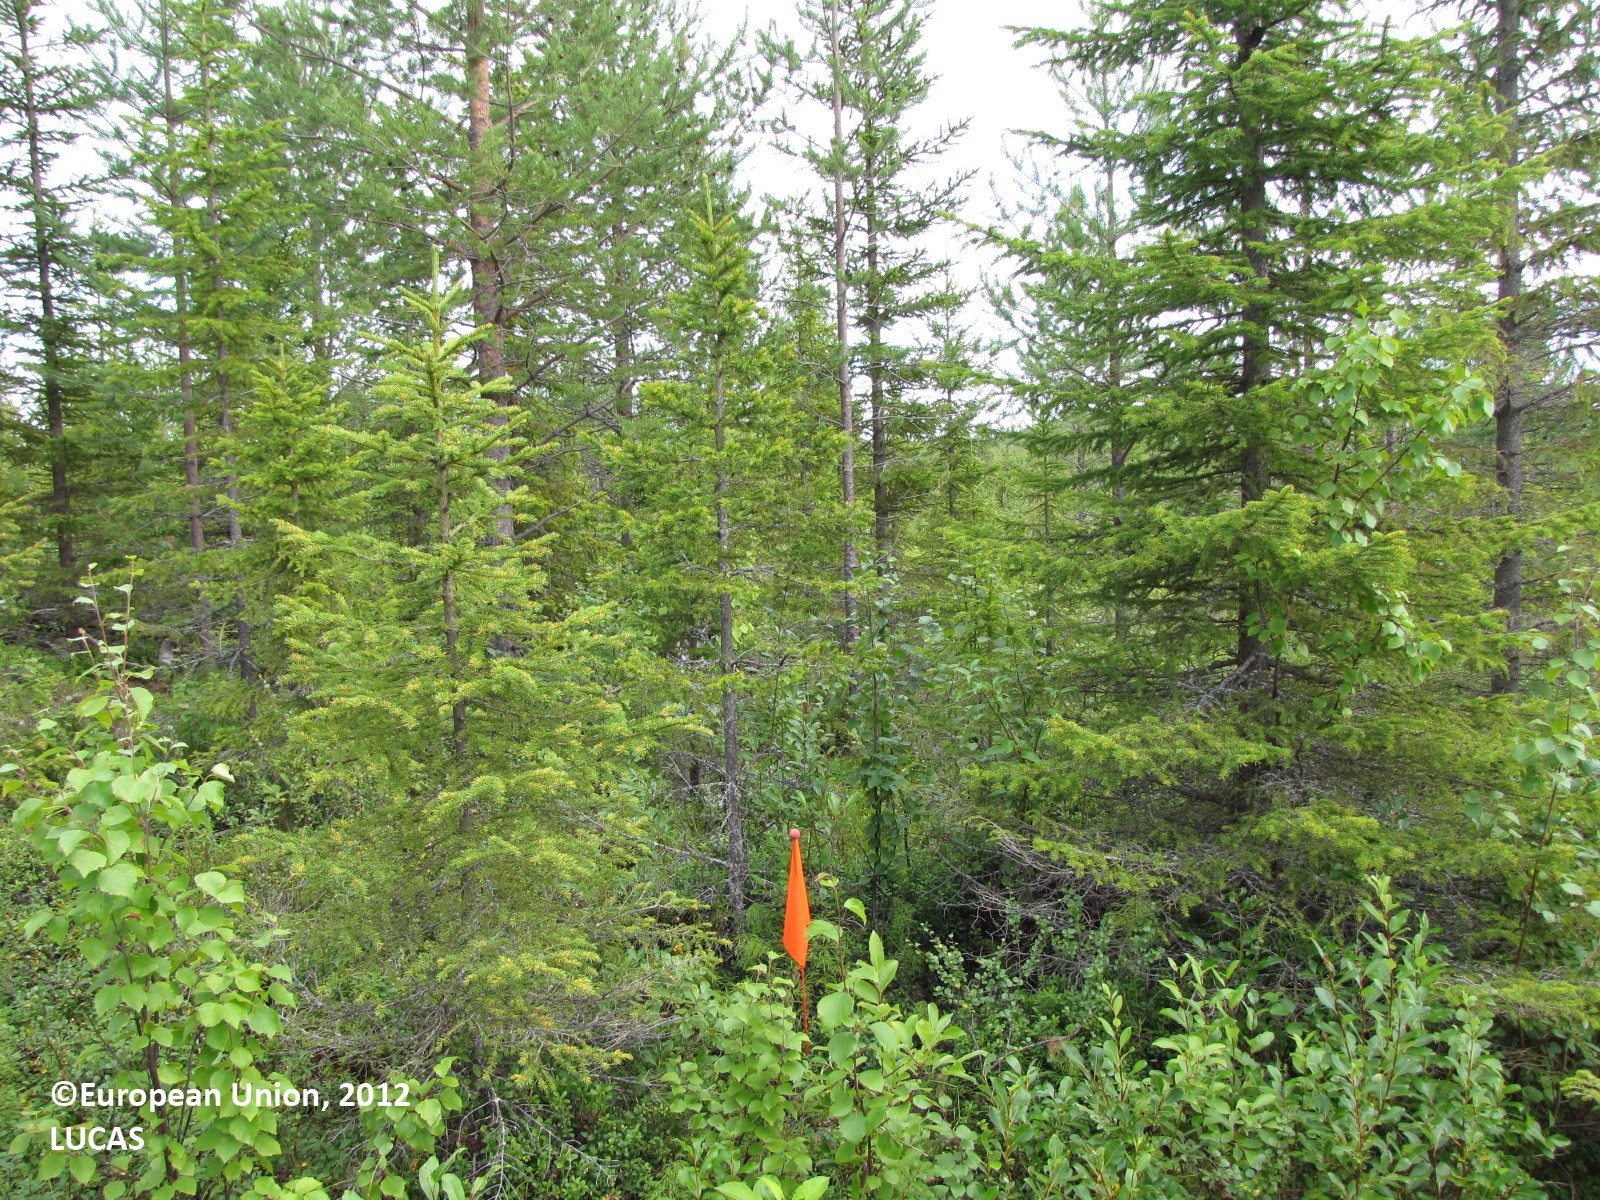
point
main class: Woodland
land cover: Spruce dominated coniferous woodland
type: boreal forest
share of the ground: 25 - 50 %
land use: Forestry
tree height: > 5 m
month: August
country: FI
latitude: 66.7819
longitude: 24.6135
